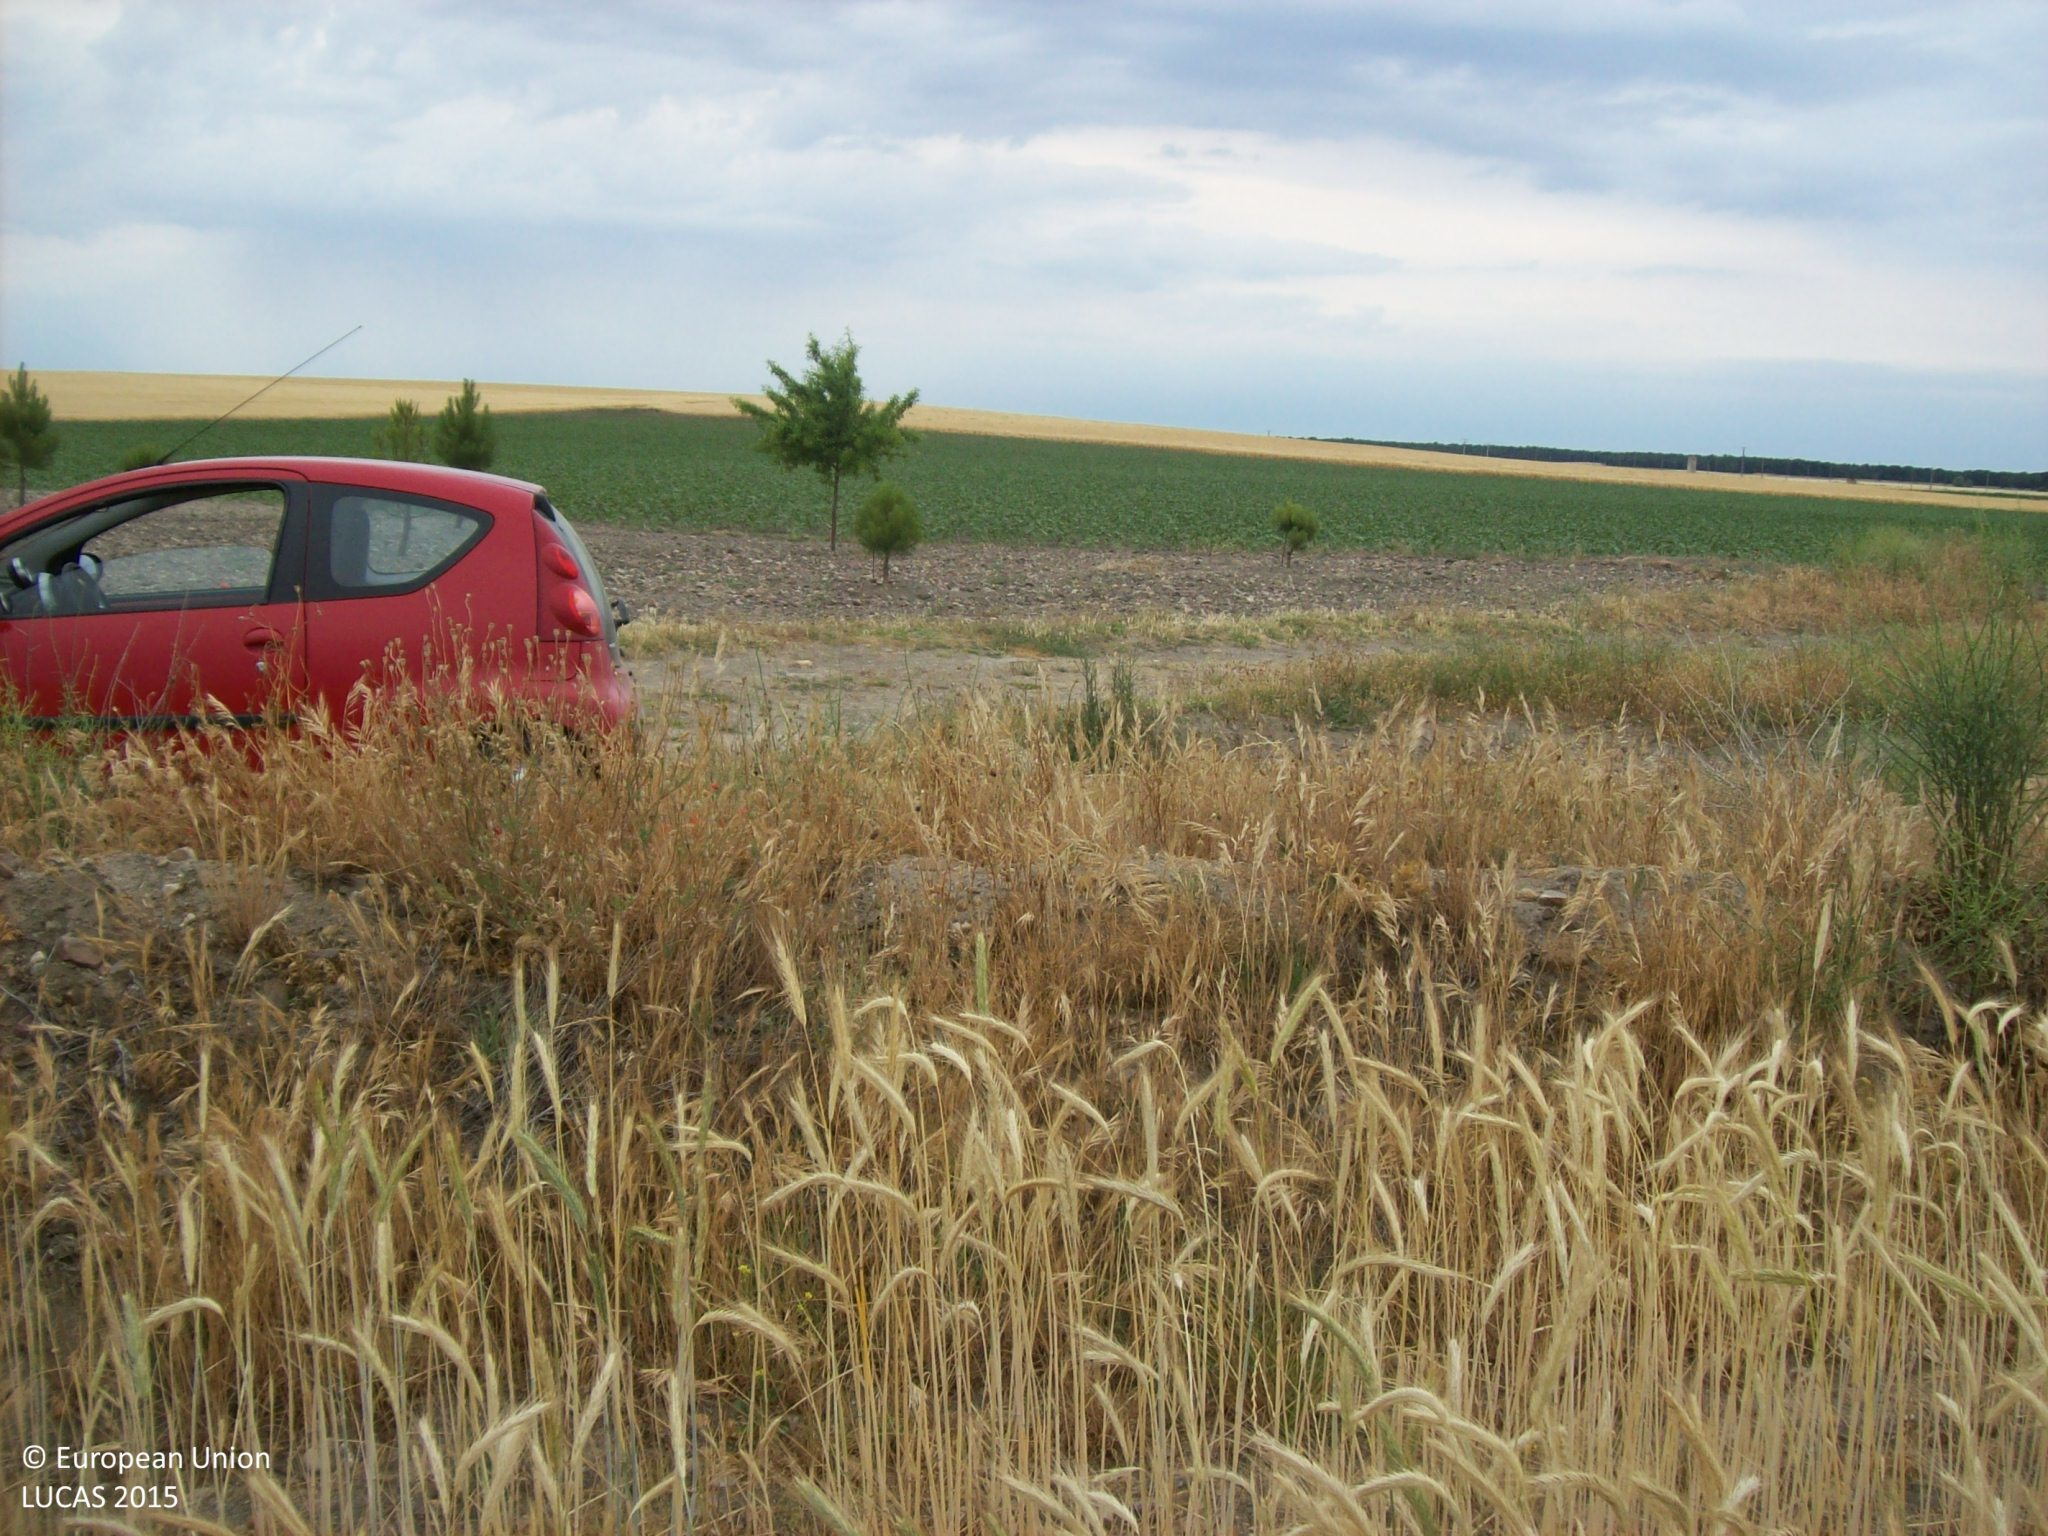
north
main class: Cropland
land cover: Rye
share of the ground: > 75 %
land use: Agriculture (excluding fallow land and kitchen gardens)
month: June
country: ES
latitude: 41.1730
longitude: -4.5665
